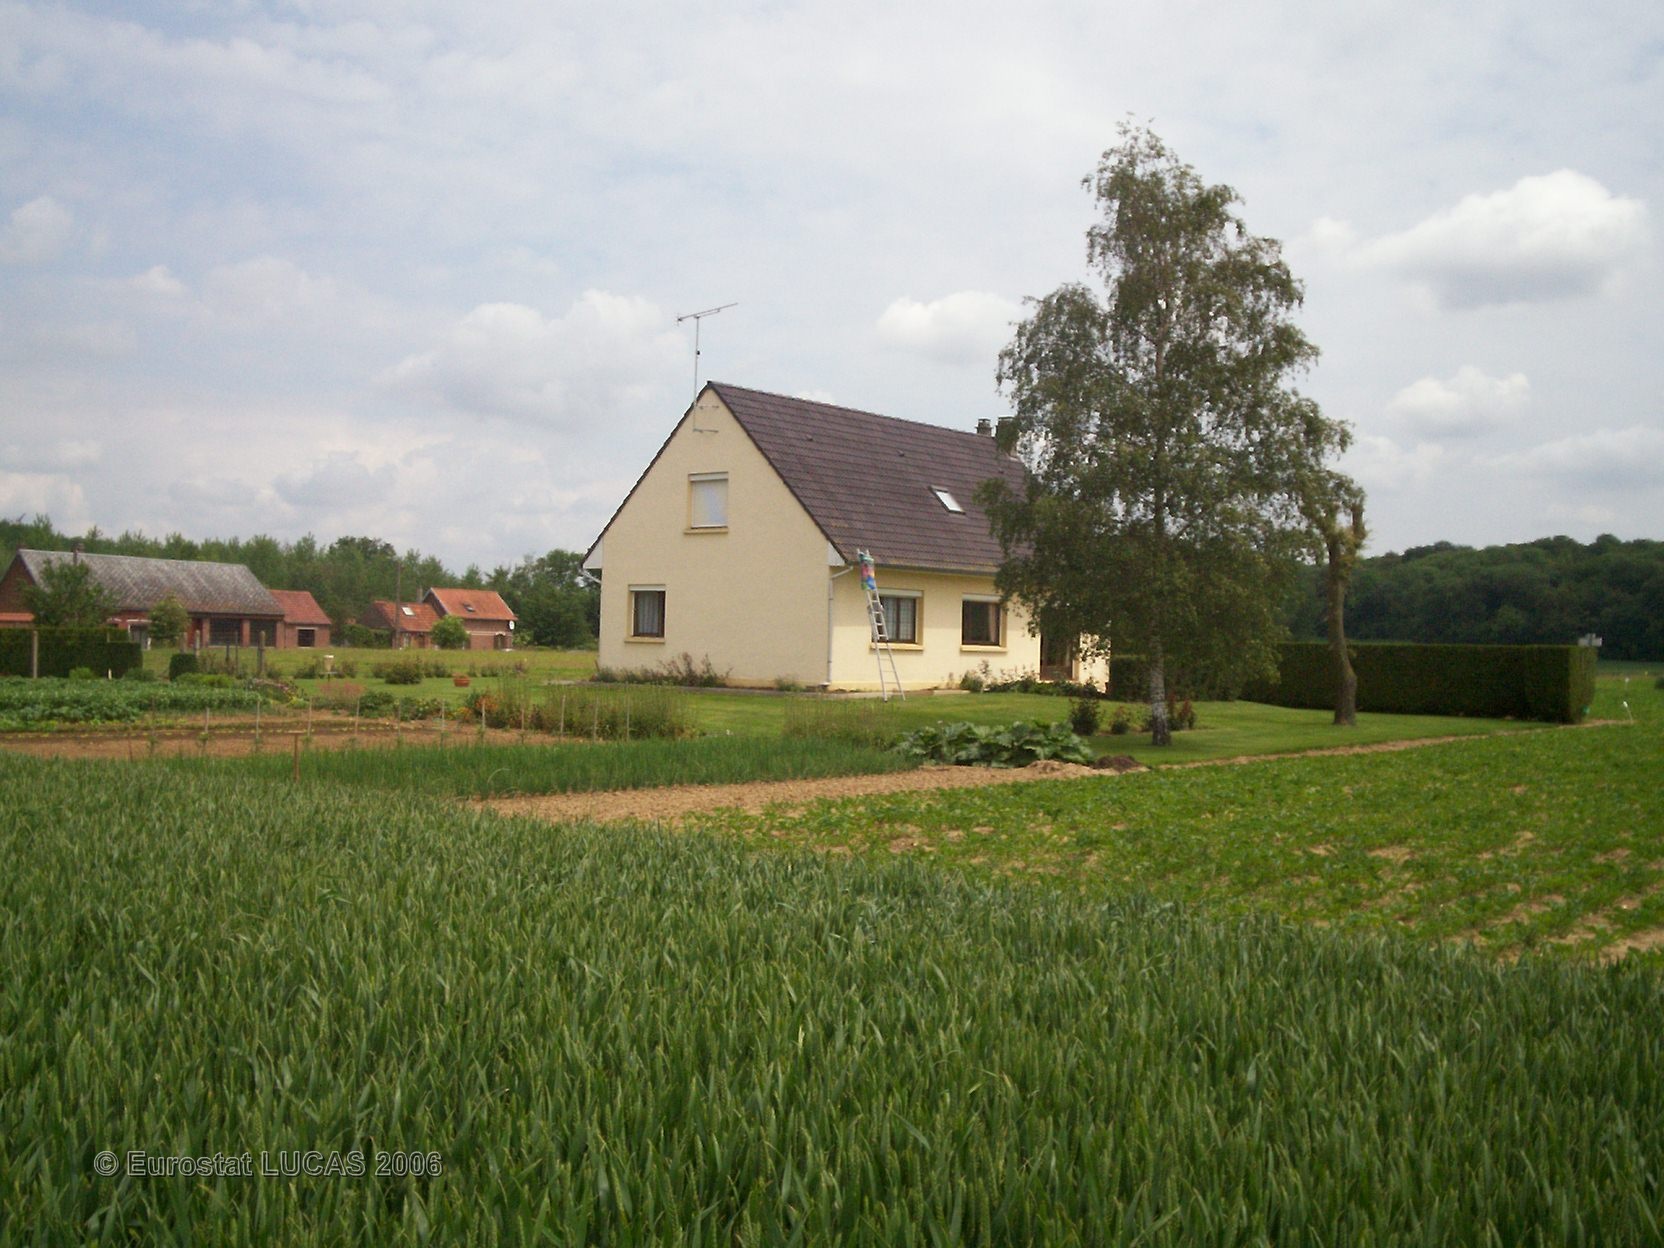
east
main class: Cropland
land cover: Common wheat
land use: Agriculture (excluding fallow land and kitchen gardens)
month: June
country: FR
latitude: 49.6926
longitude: 2.6275
